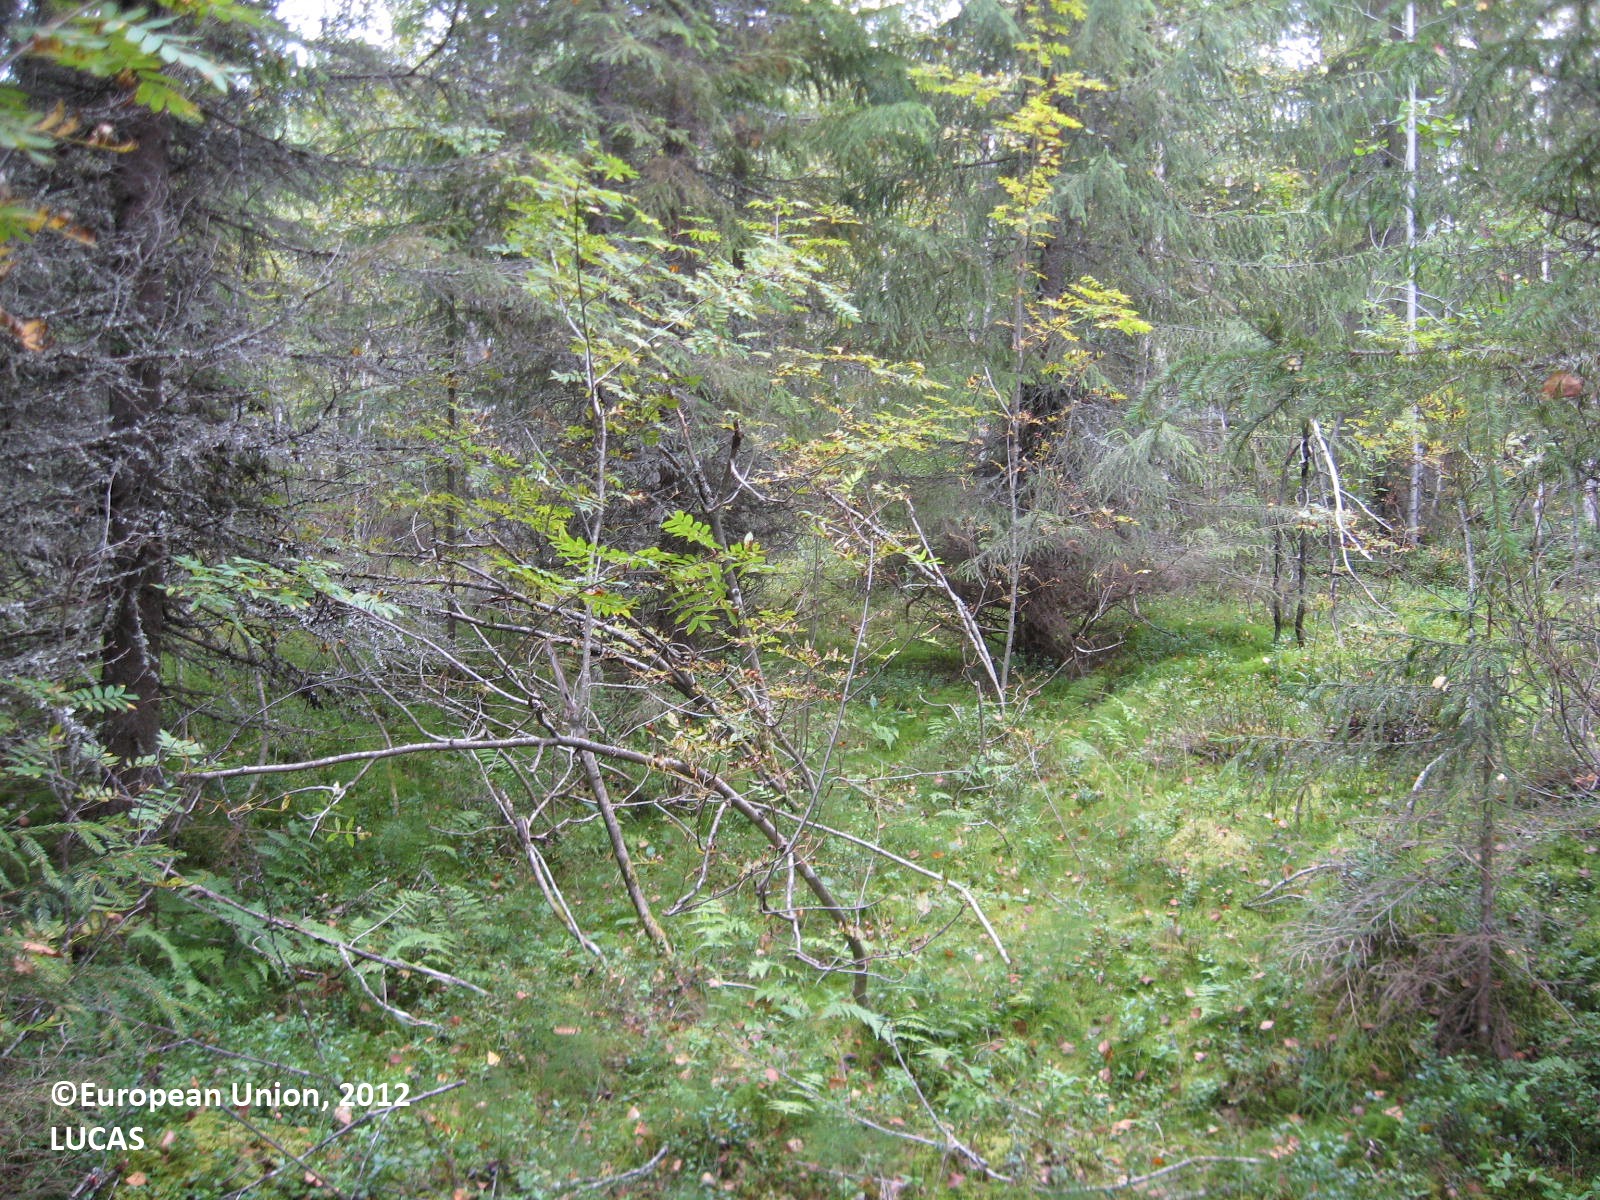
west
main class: Woodland
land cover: Other mixed woodland
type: boreal forest
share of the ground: 50 - 75 %
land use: Forestry
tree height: > 5 m
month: August
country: FI
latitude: 63.7686
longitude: 29.0445
